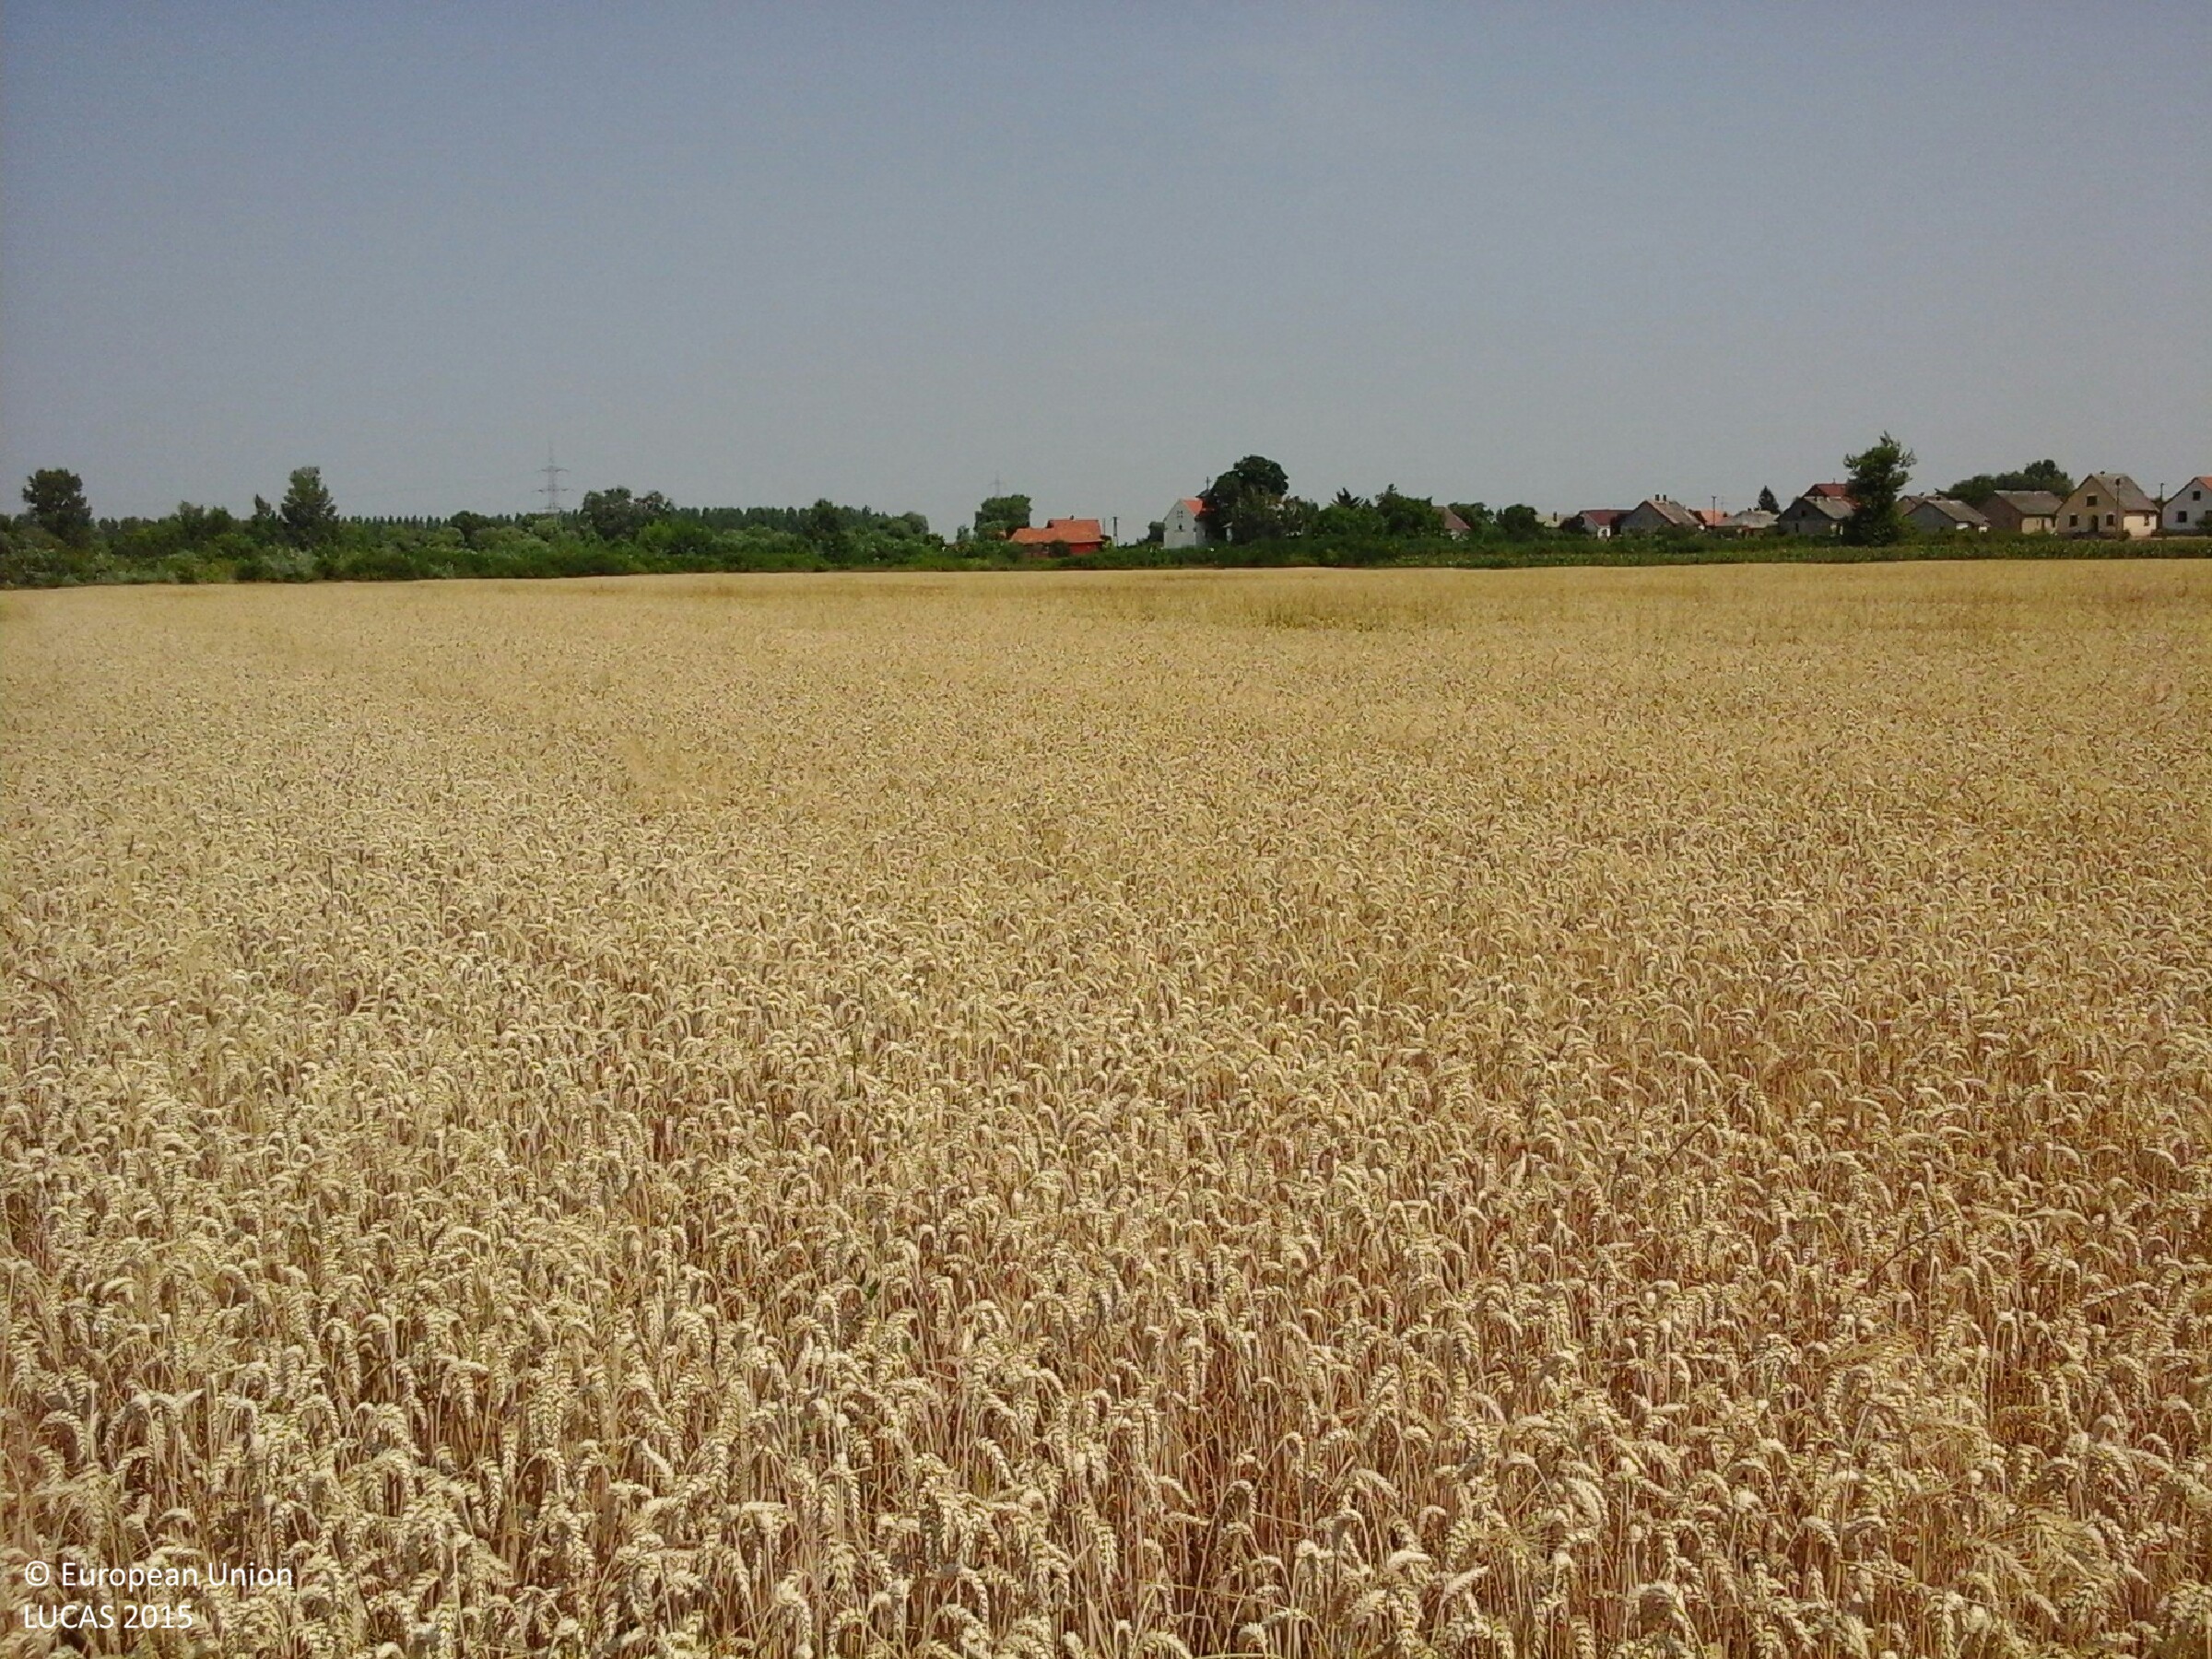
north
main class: Cropland
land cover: Common wheat
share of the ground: > 75 %
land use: Agriculture (excluding fallow land and kitchen gardens)
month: July
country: HU
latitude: 47.9611
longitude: 21.0072
